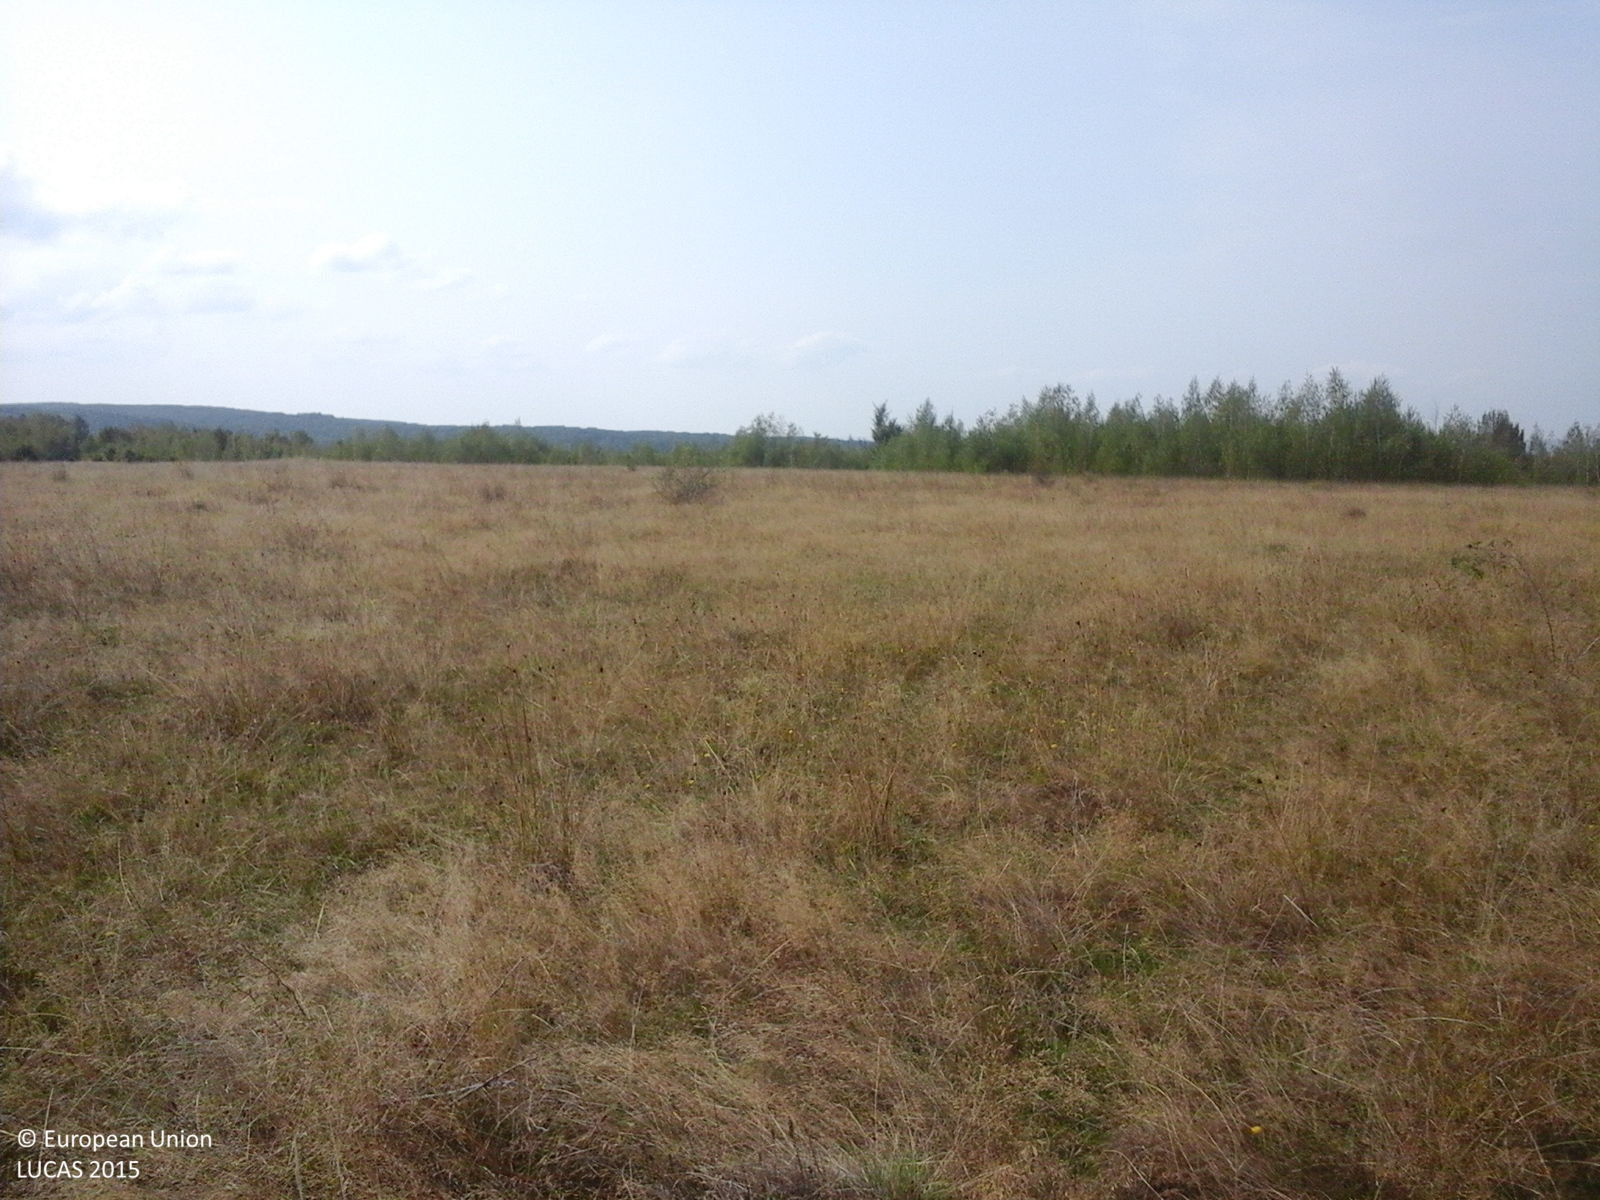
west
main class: Grassland
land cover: Grassland with sparse tree/shrub cover
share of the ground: > 75 %
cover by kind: herbaceous plants 85 %, shrubs 10 %, broadleaved forest trees 5 %
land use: Agriculture (excluding fallow land and kitchen gardens)
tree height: < 5 m
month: September
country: RO
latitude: 45.8044
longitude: 22.2809
